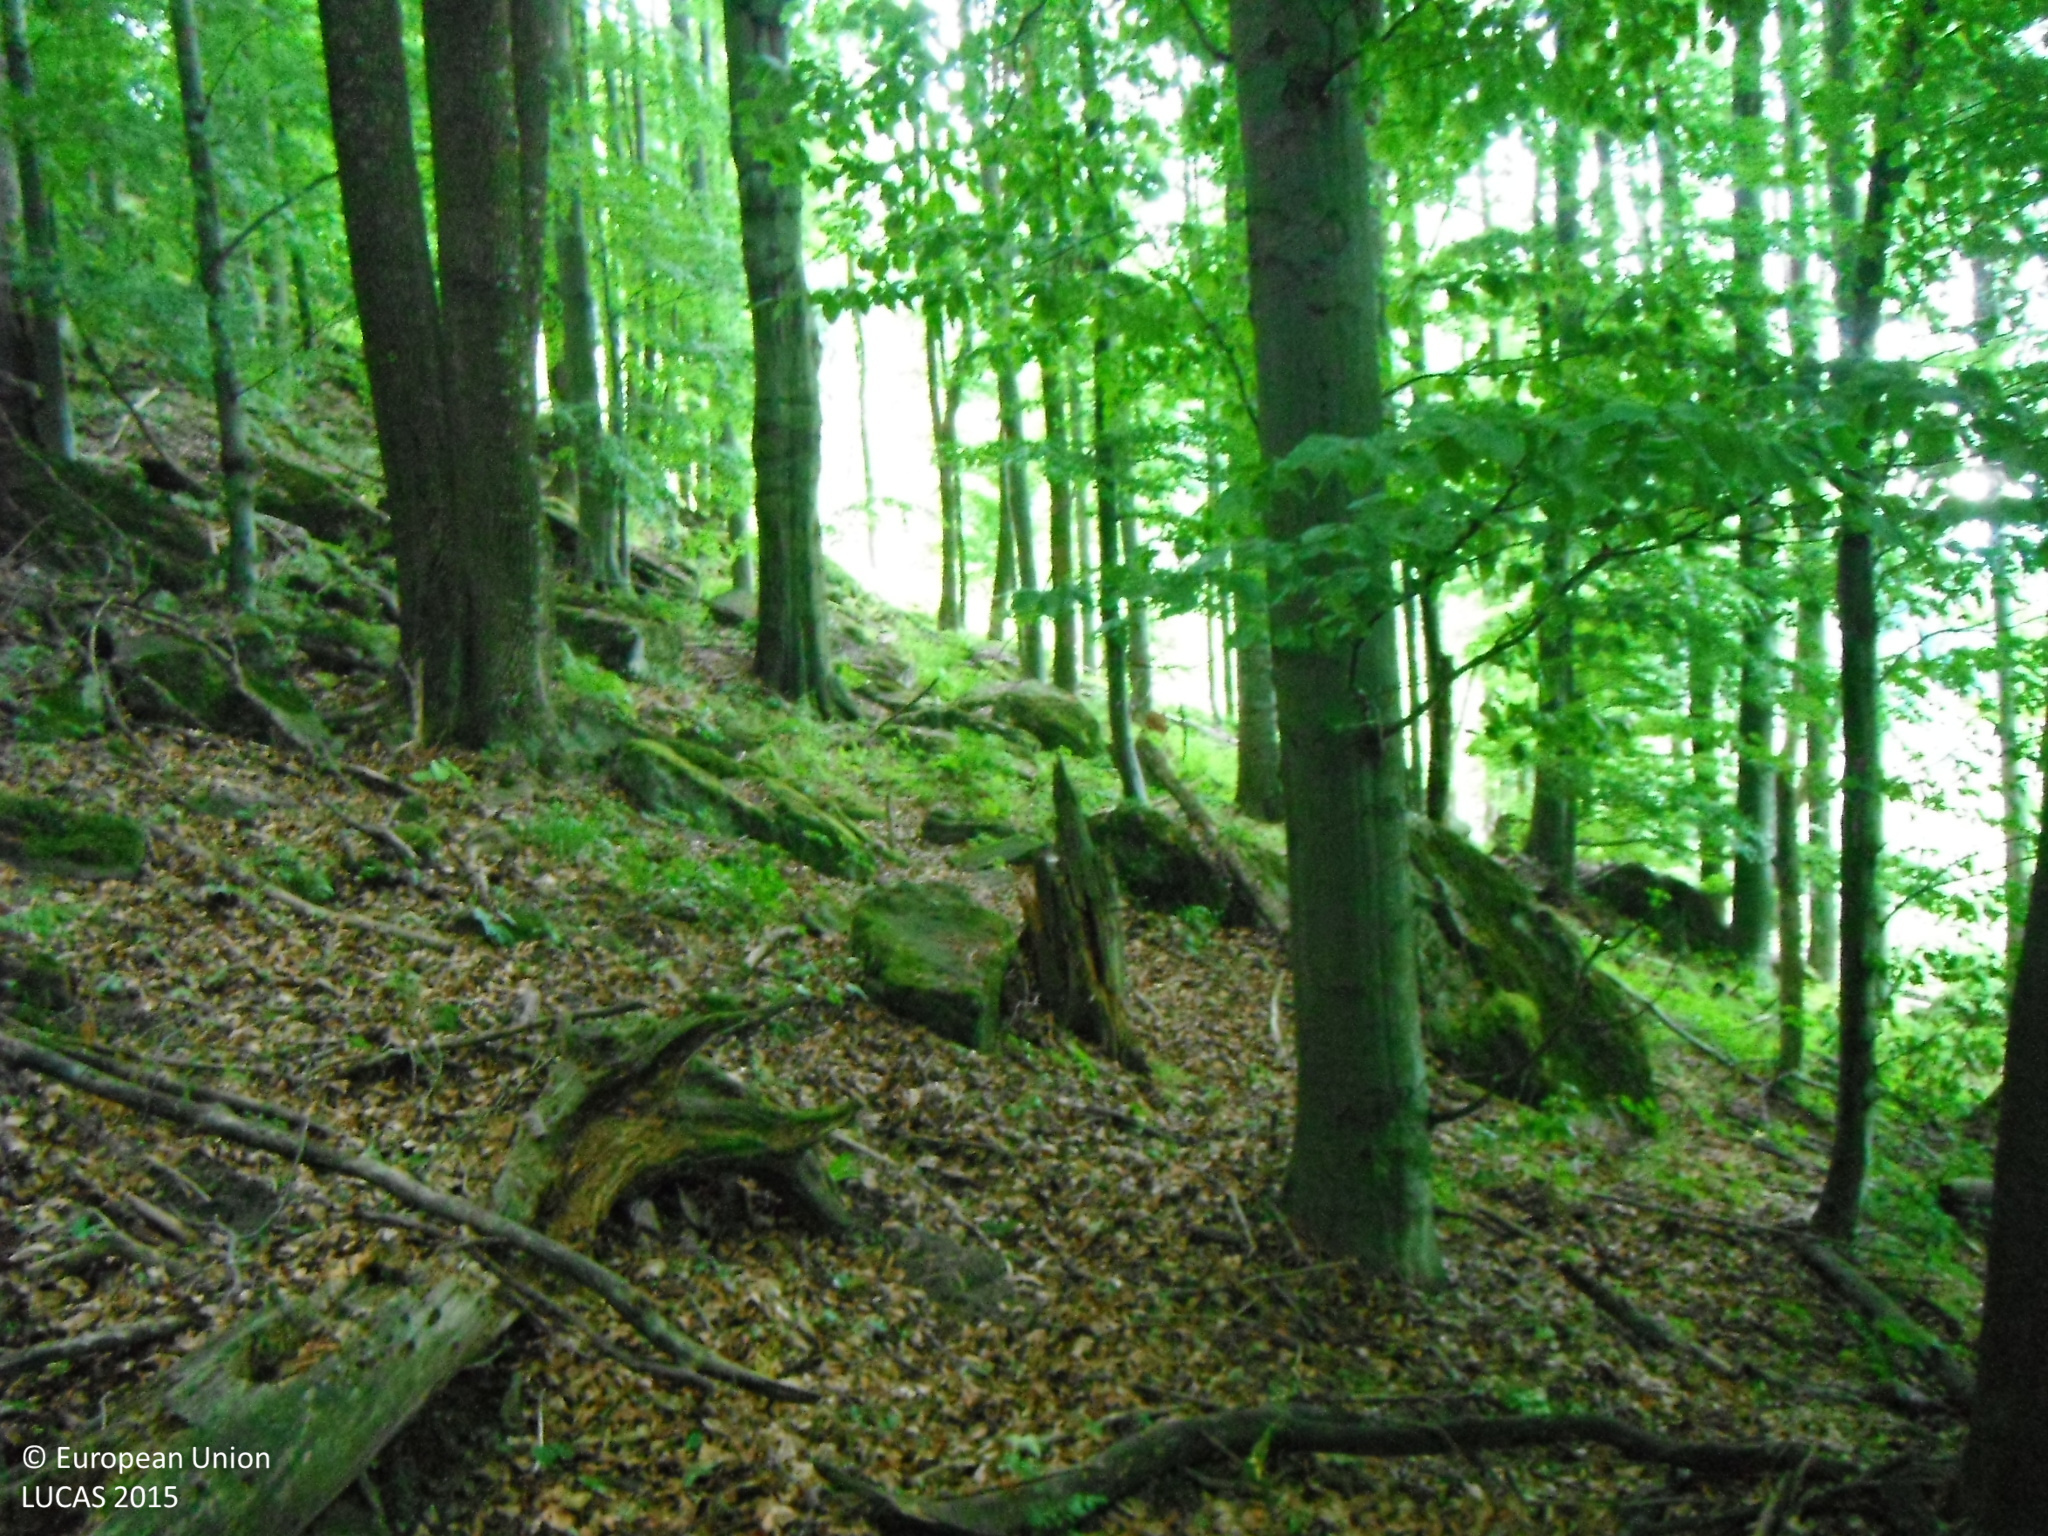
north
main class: Woodland
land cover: Broadleaved woodland
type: beech forest
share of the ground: > 75 %
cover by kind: broadleaved forest trees 95 %, herbaceous plants 5 %
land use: Forestry
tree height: > 5 m
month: June
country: SK
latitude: 48.5663
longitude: 18.7049
